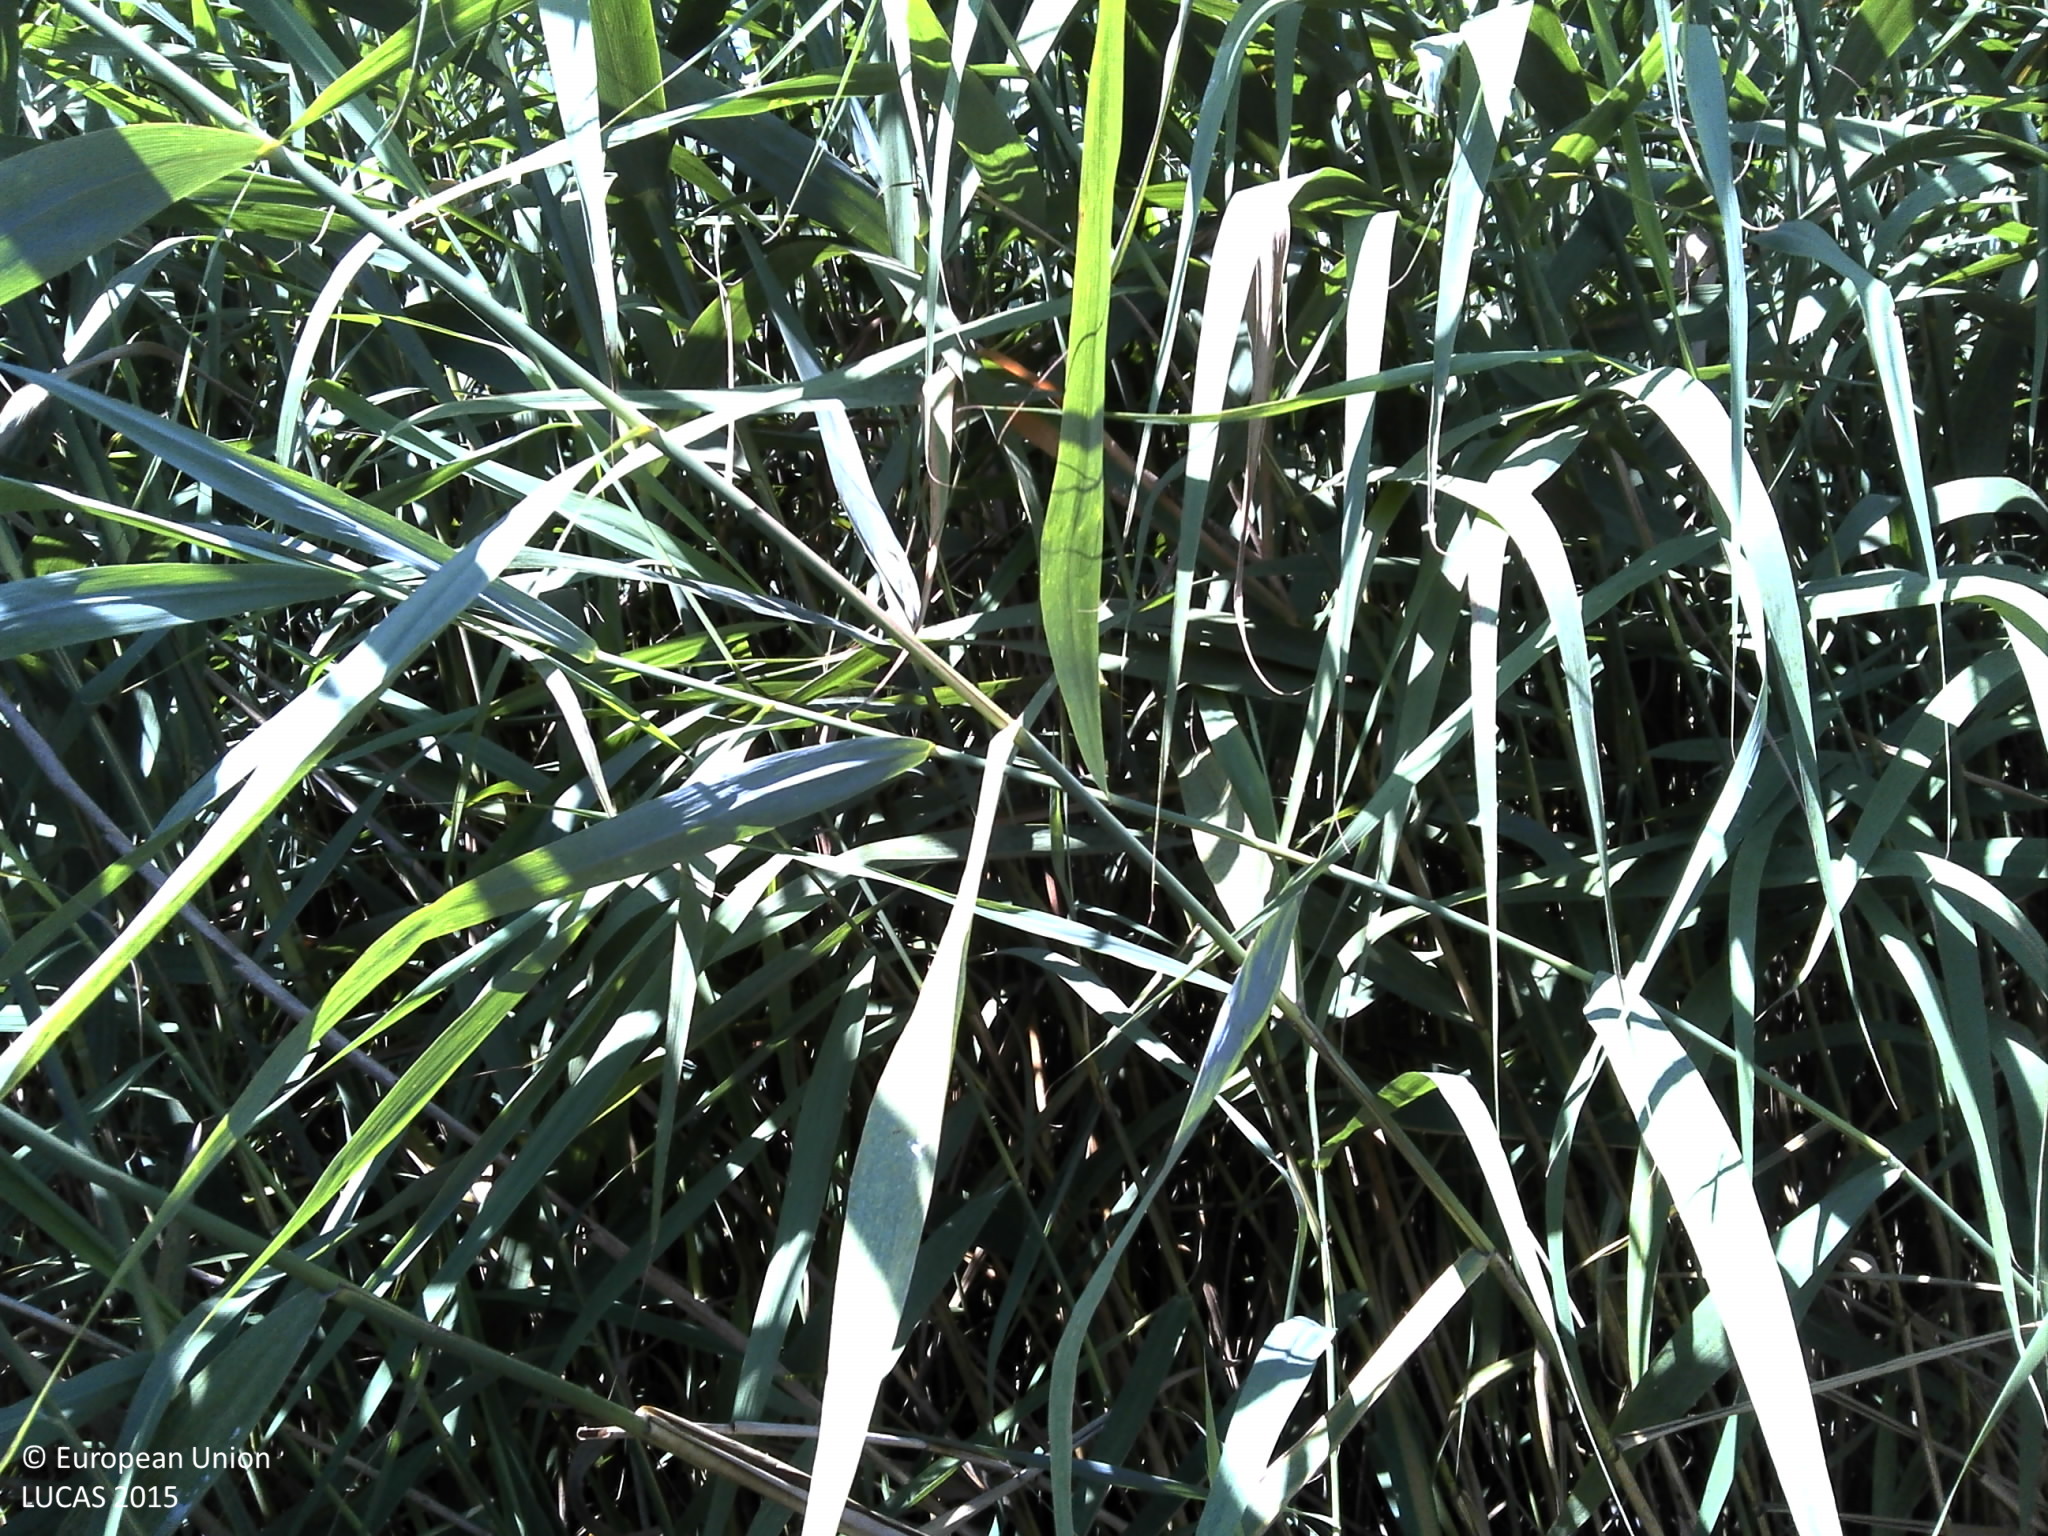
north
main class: Grassland
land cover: Spontaneously vegetated surfaces
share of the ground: > 75 %
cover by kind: herbaceous plants 100 %
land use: Semi-natural and natural areas not in use
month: July
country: HR
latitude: 45.4257
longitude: 16.8623
